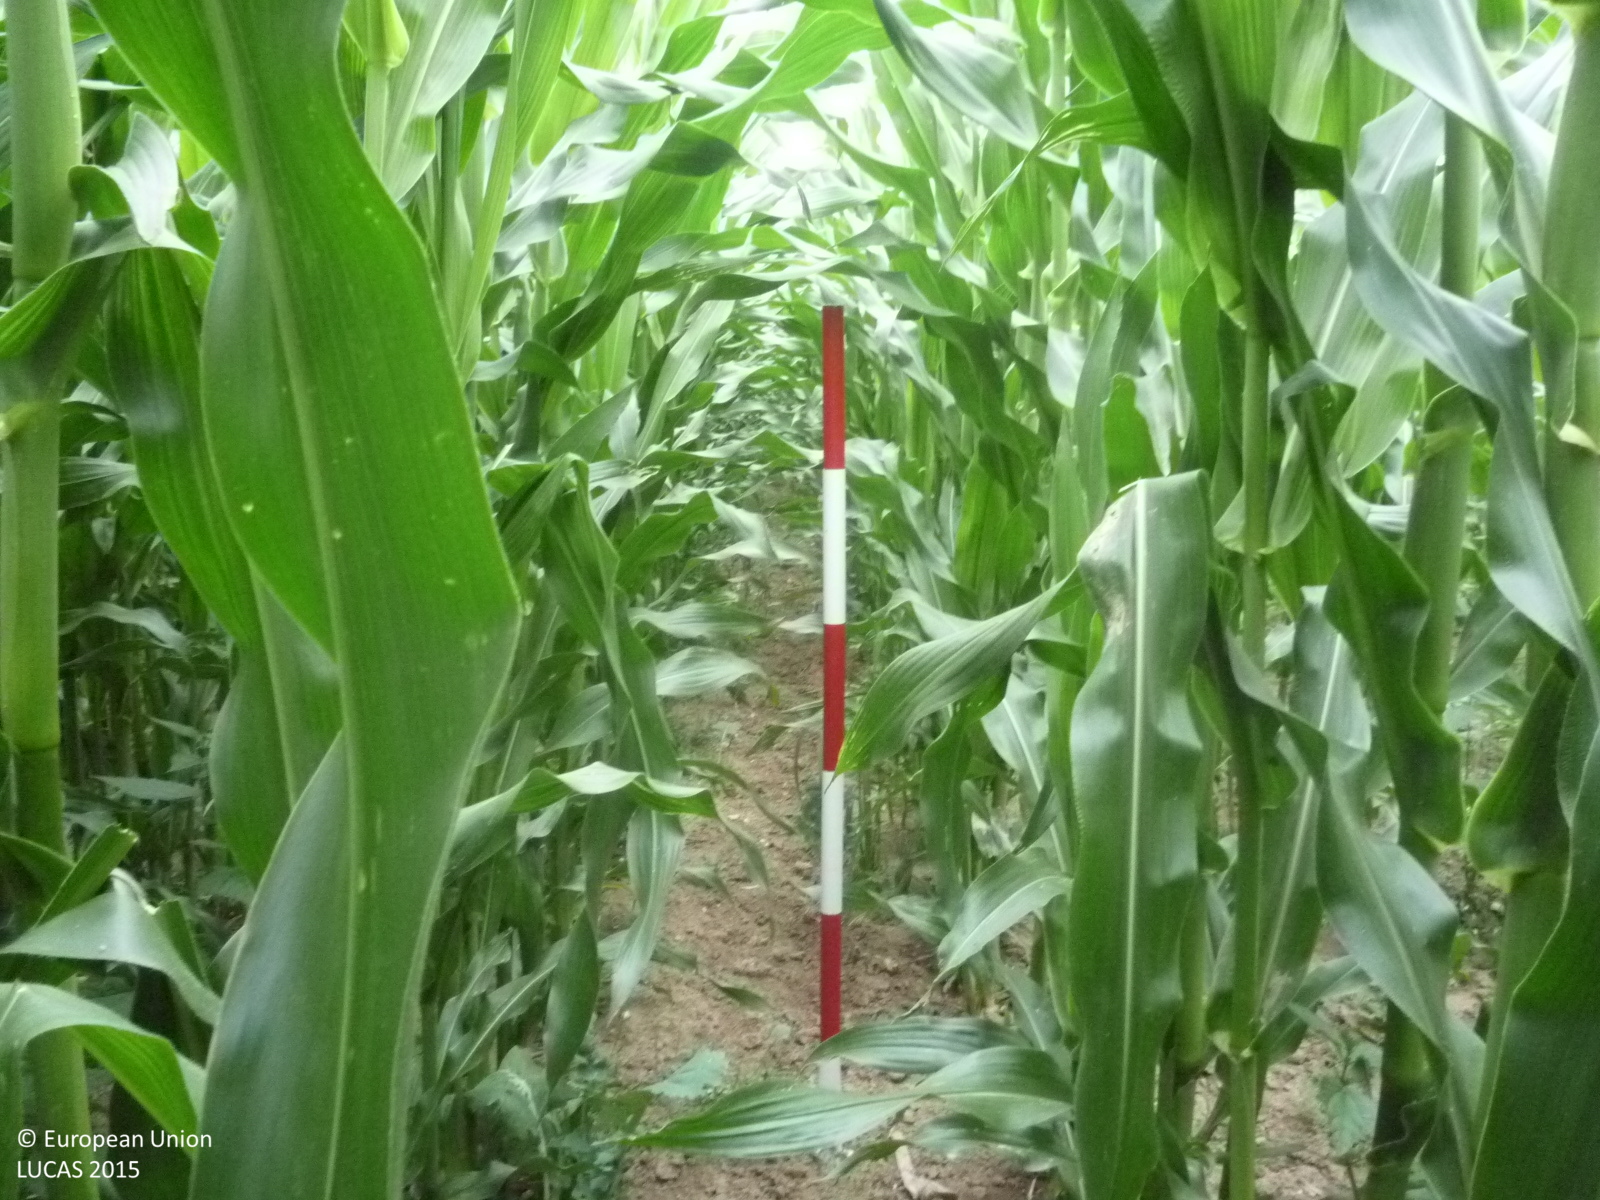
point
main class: Cropland
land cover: Maize
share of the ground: > 75 %
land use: Agriculture (excluding fallow land and kitchen gardens)
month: July
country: CZ
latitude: 50.2974
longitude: 15.6338
